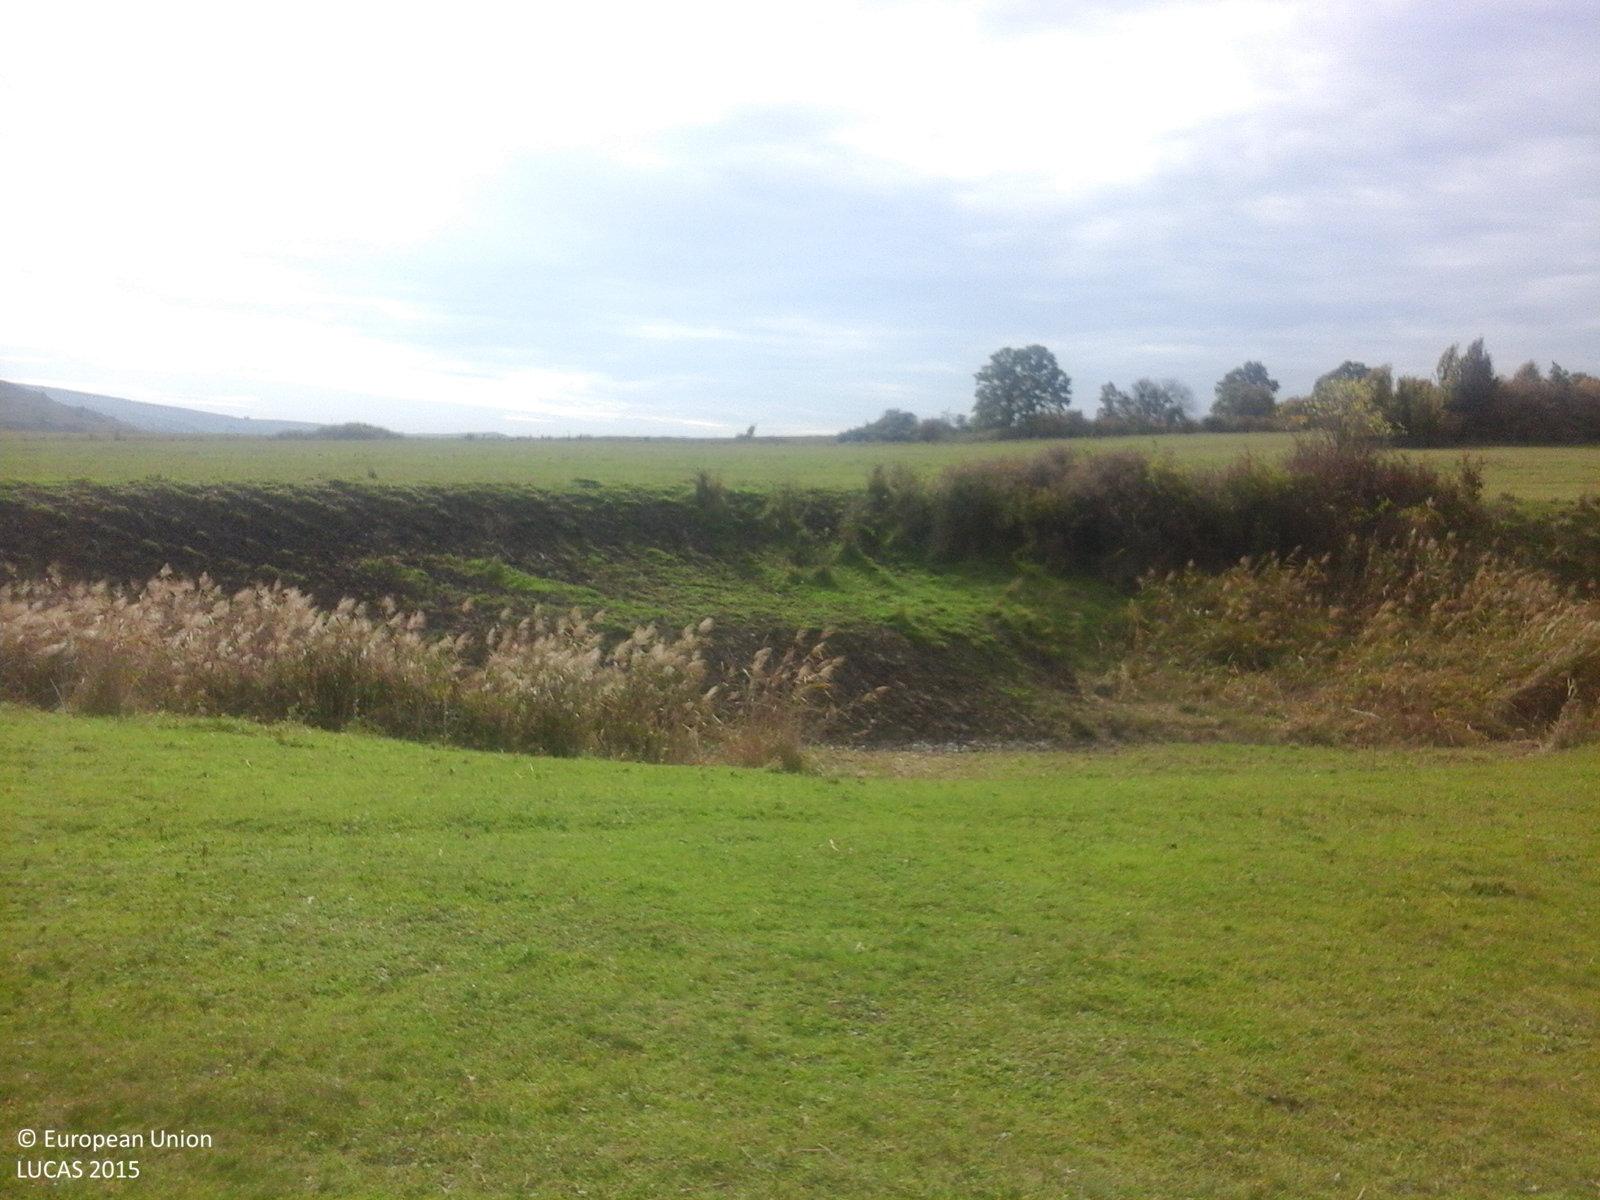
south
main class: Grassland
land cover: Grassland without tree/shrub cover
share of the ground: > 75 %
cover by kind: herbaceous plants 100 %
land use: Agriculture (excluding fallow land and kitchen gardens)
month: October
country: RO
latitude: 46.2130
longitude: 25.1743
